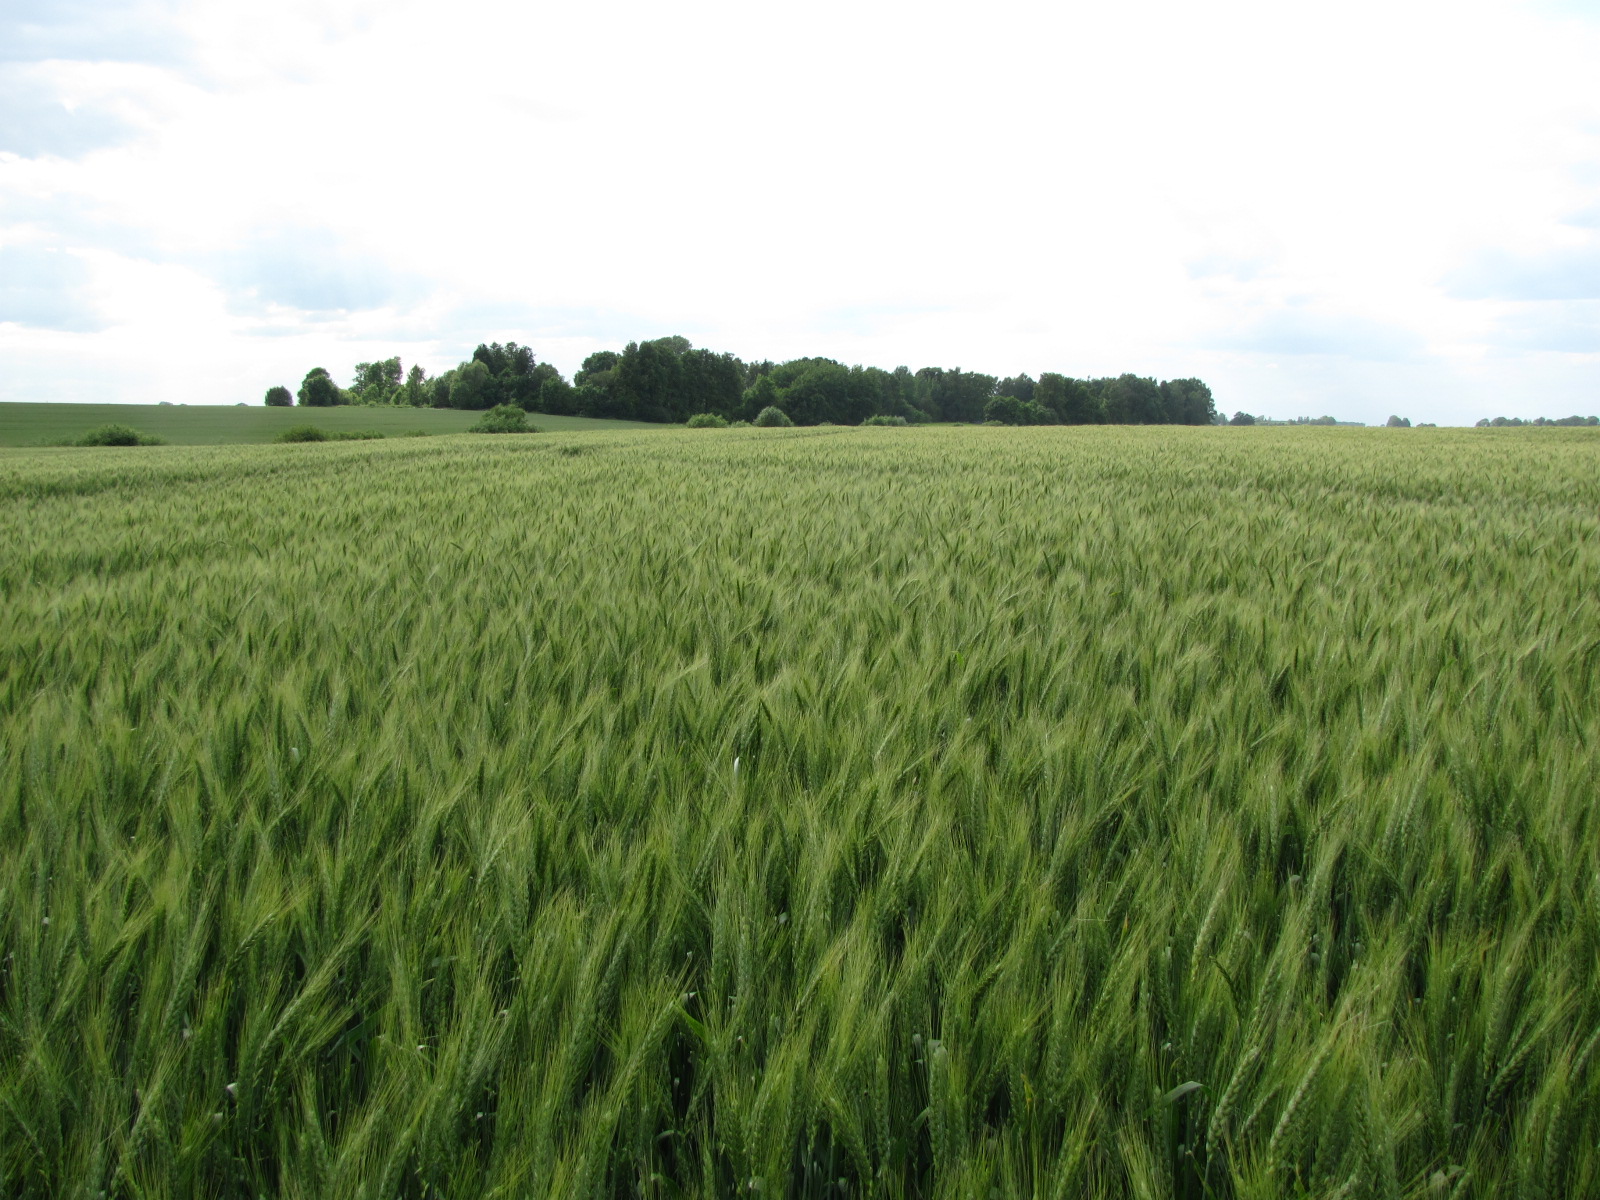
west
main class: Cropland
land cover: Triticale
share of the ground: > 75 %
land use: Agriculture (excluding fallow land and kitchen gardens)
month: June
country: LV
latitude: 56.5108
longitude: 24.0115
